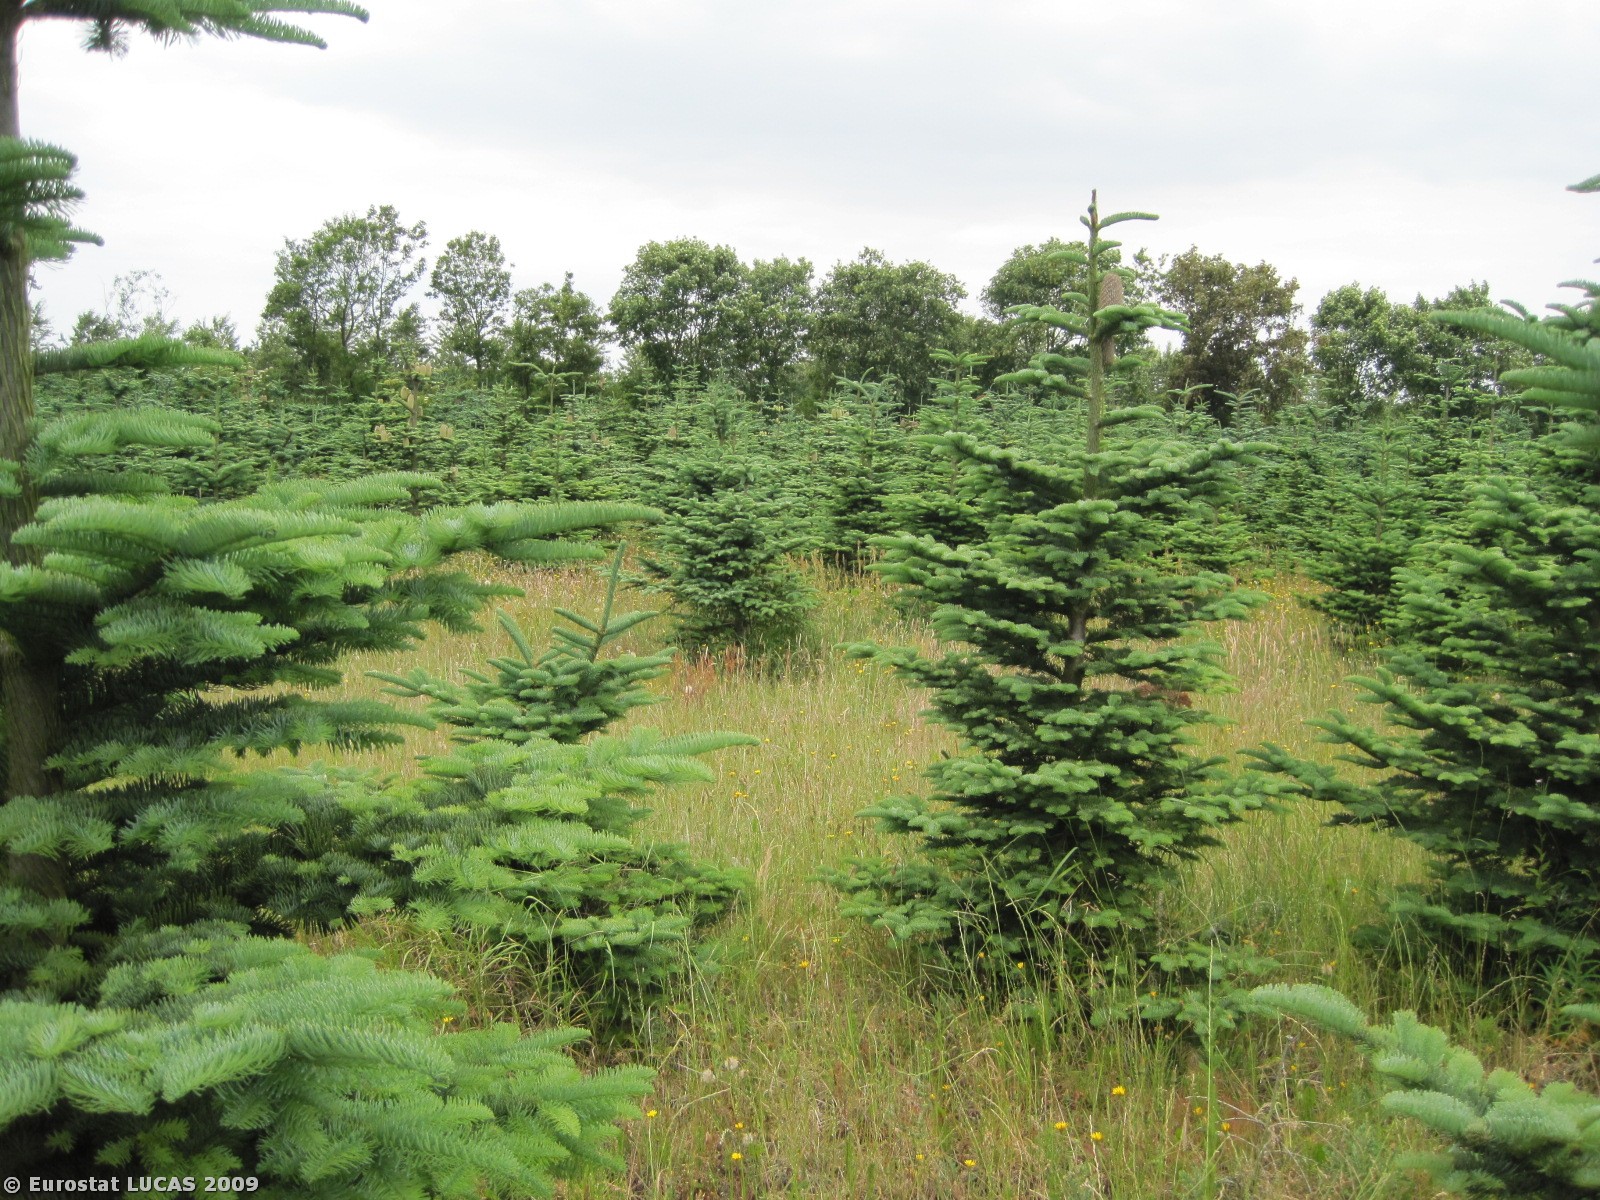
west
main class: Woodland
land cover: Coniferous woodland
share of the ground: 50 - 75 %
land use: Forestry
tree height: > 5 m
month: June
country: DK
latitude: 56.3216
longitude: 8.4011
